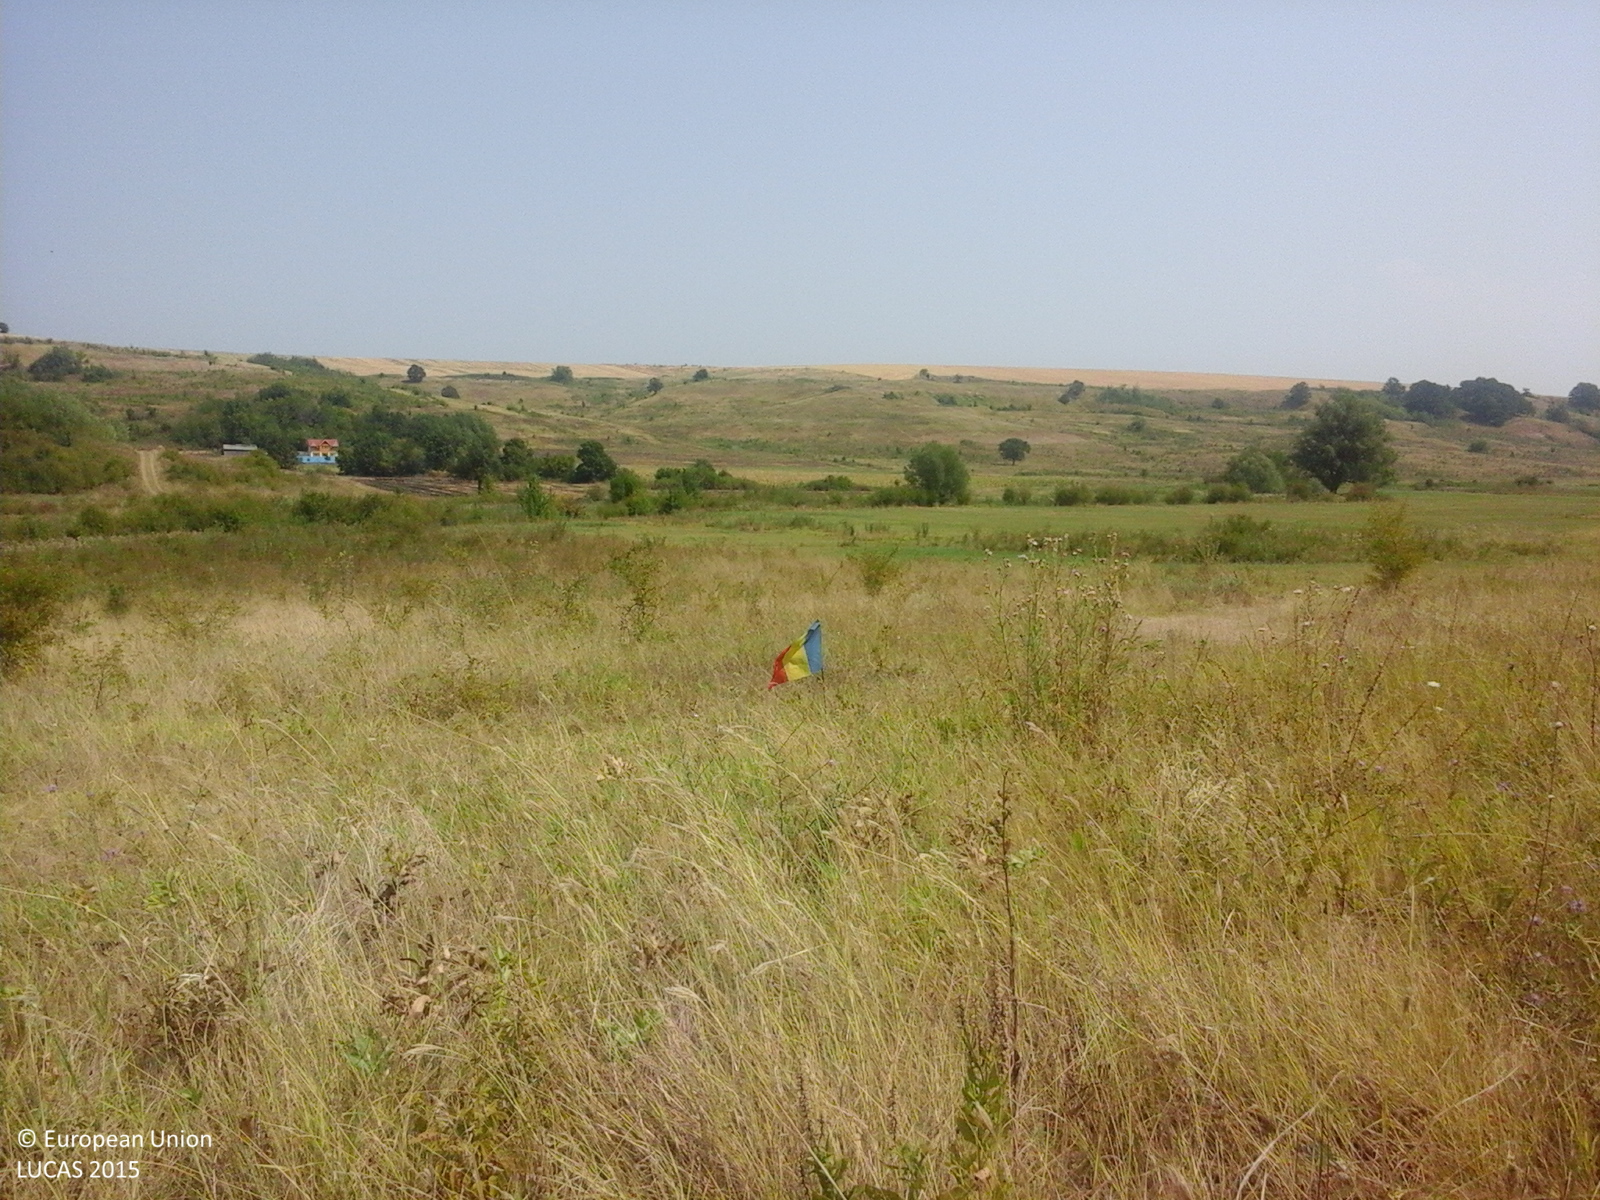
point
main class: Grassland
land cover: Spontaneously vegetated surfaces
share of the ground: > 75 %
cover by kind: herbaceous plants 100 %
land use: Fallow land
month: August
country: RO
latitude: 44.3762
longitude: 23.3662
